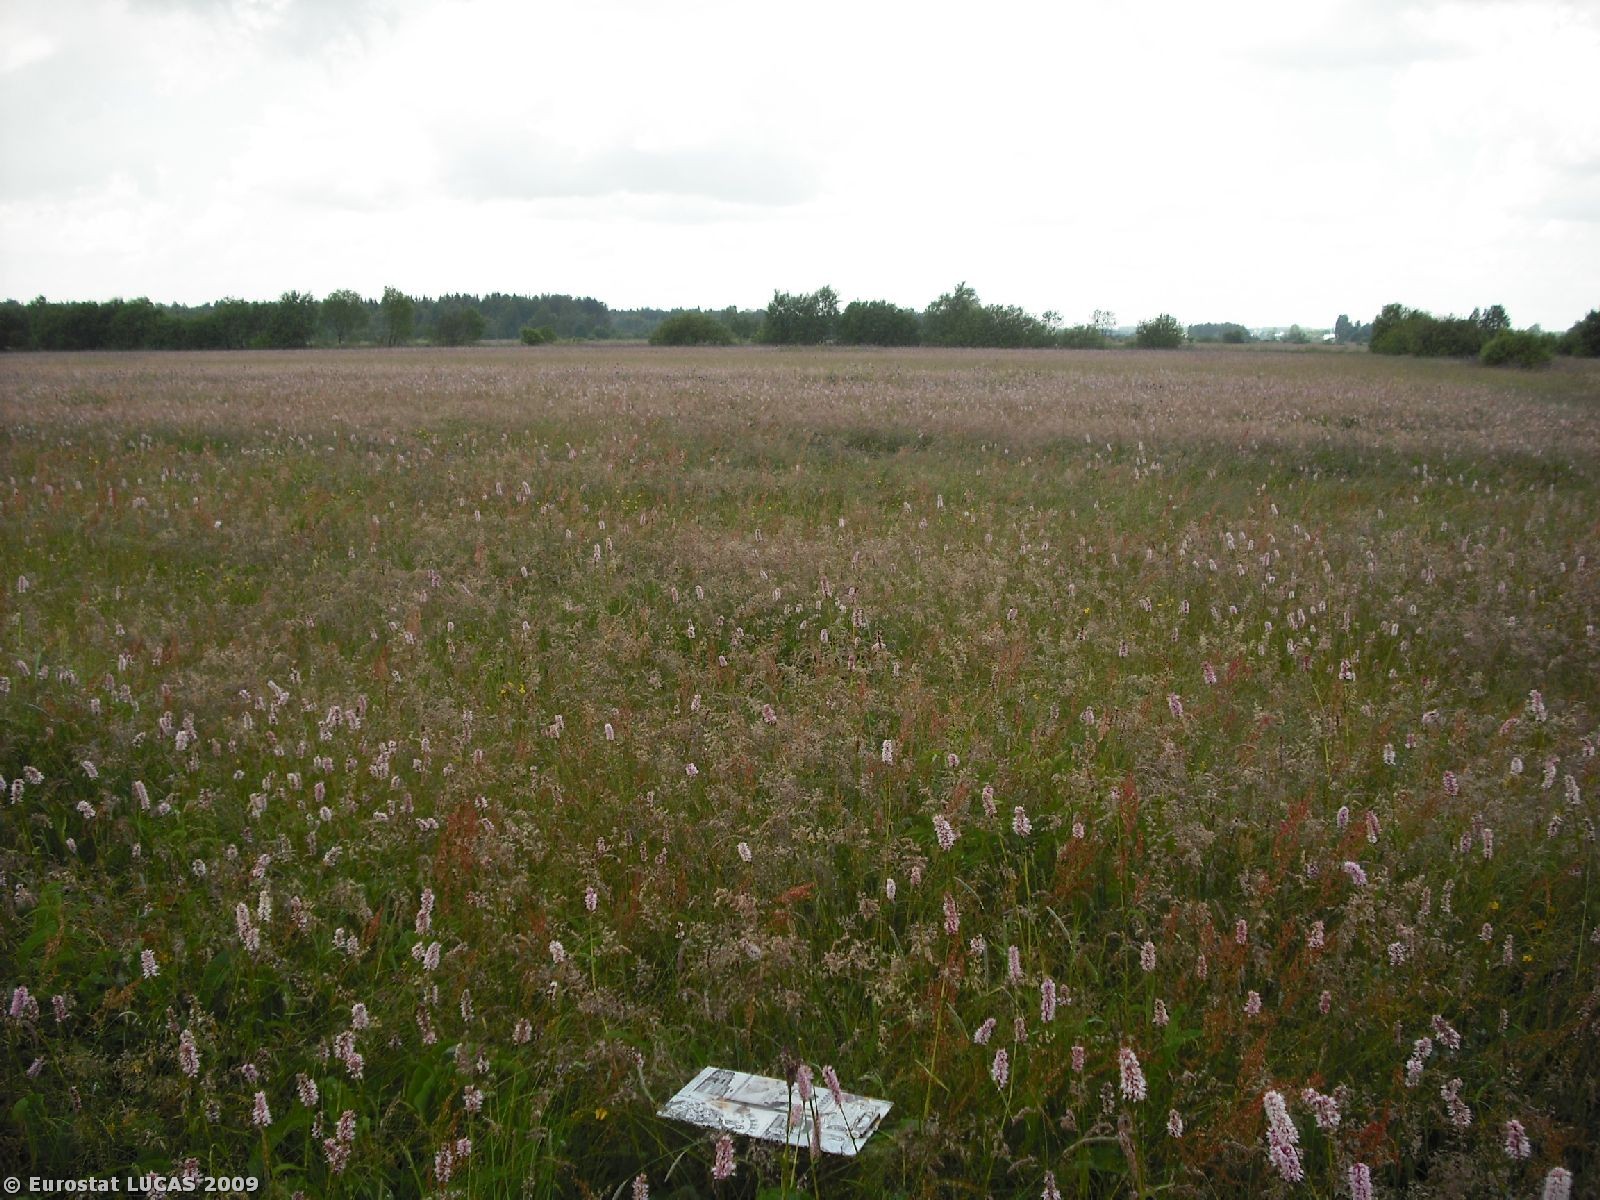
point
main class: Grassland
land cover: Grassland without tree/shrub cover
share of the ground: > 75 %
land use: Agriculture (excluding fallow land and kitchen gardens)
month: June
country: PL
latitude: 53.6975
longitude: 23.5182
